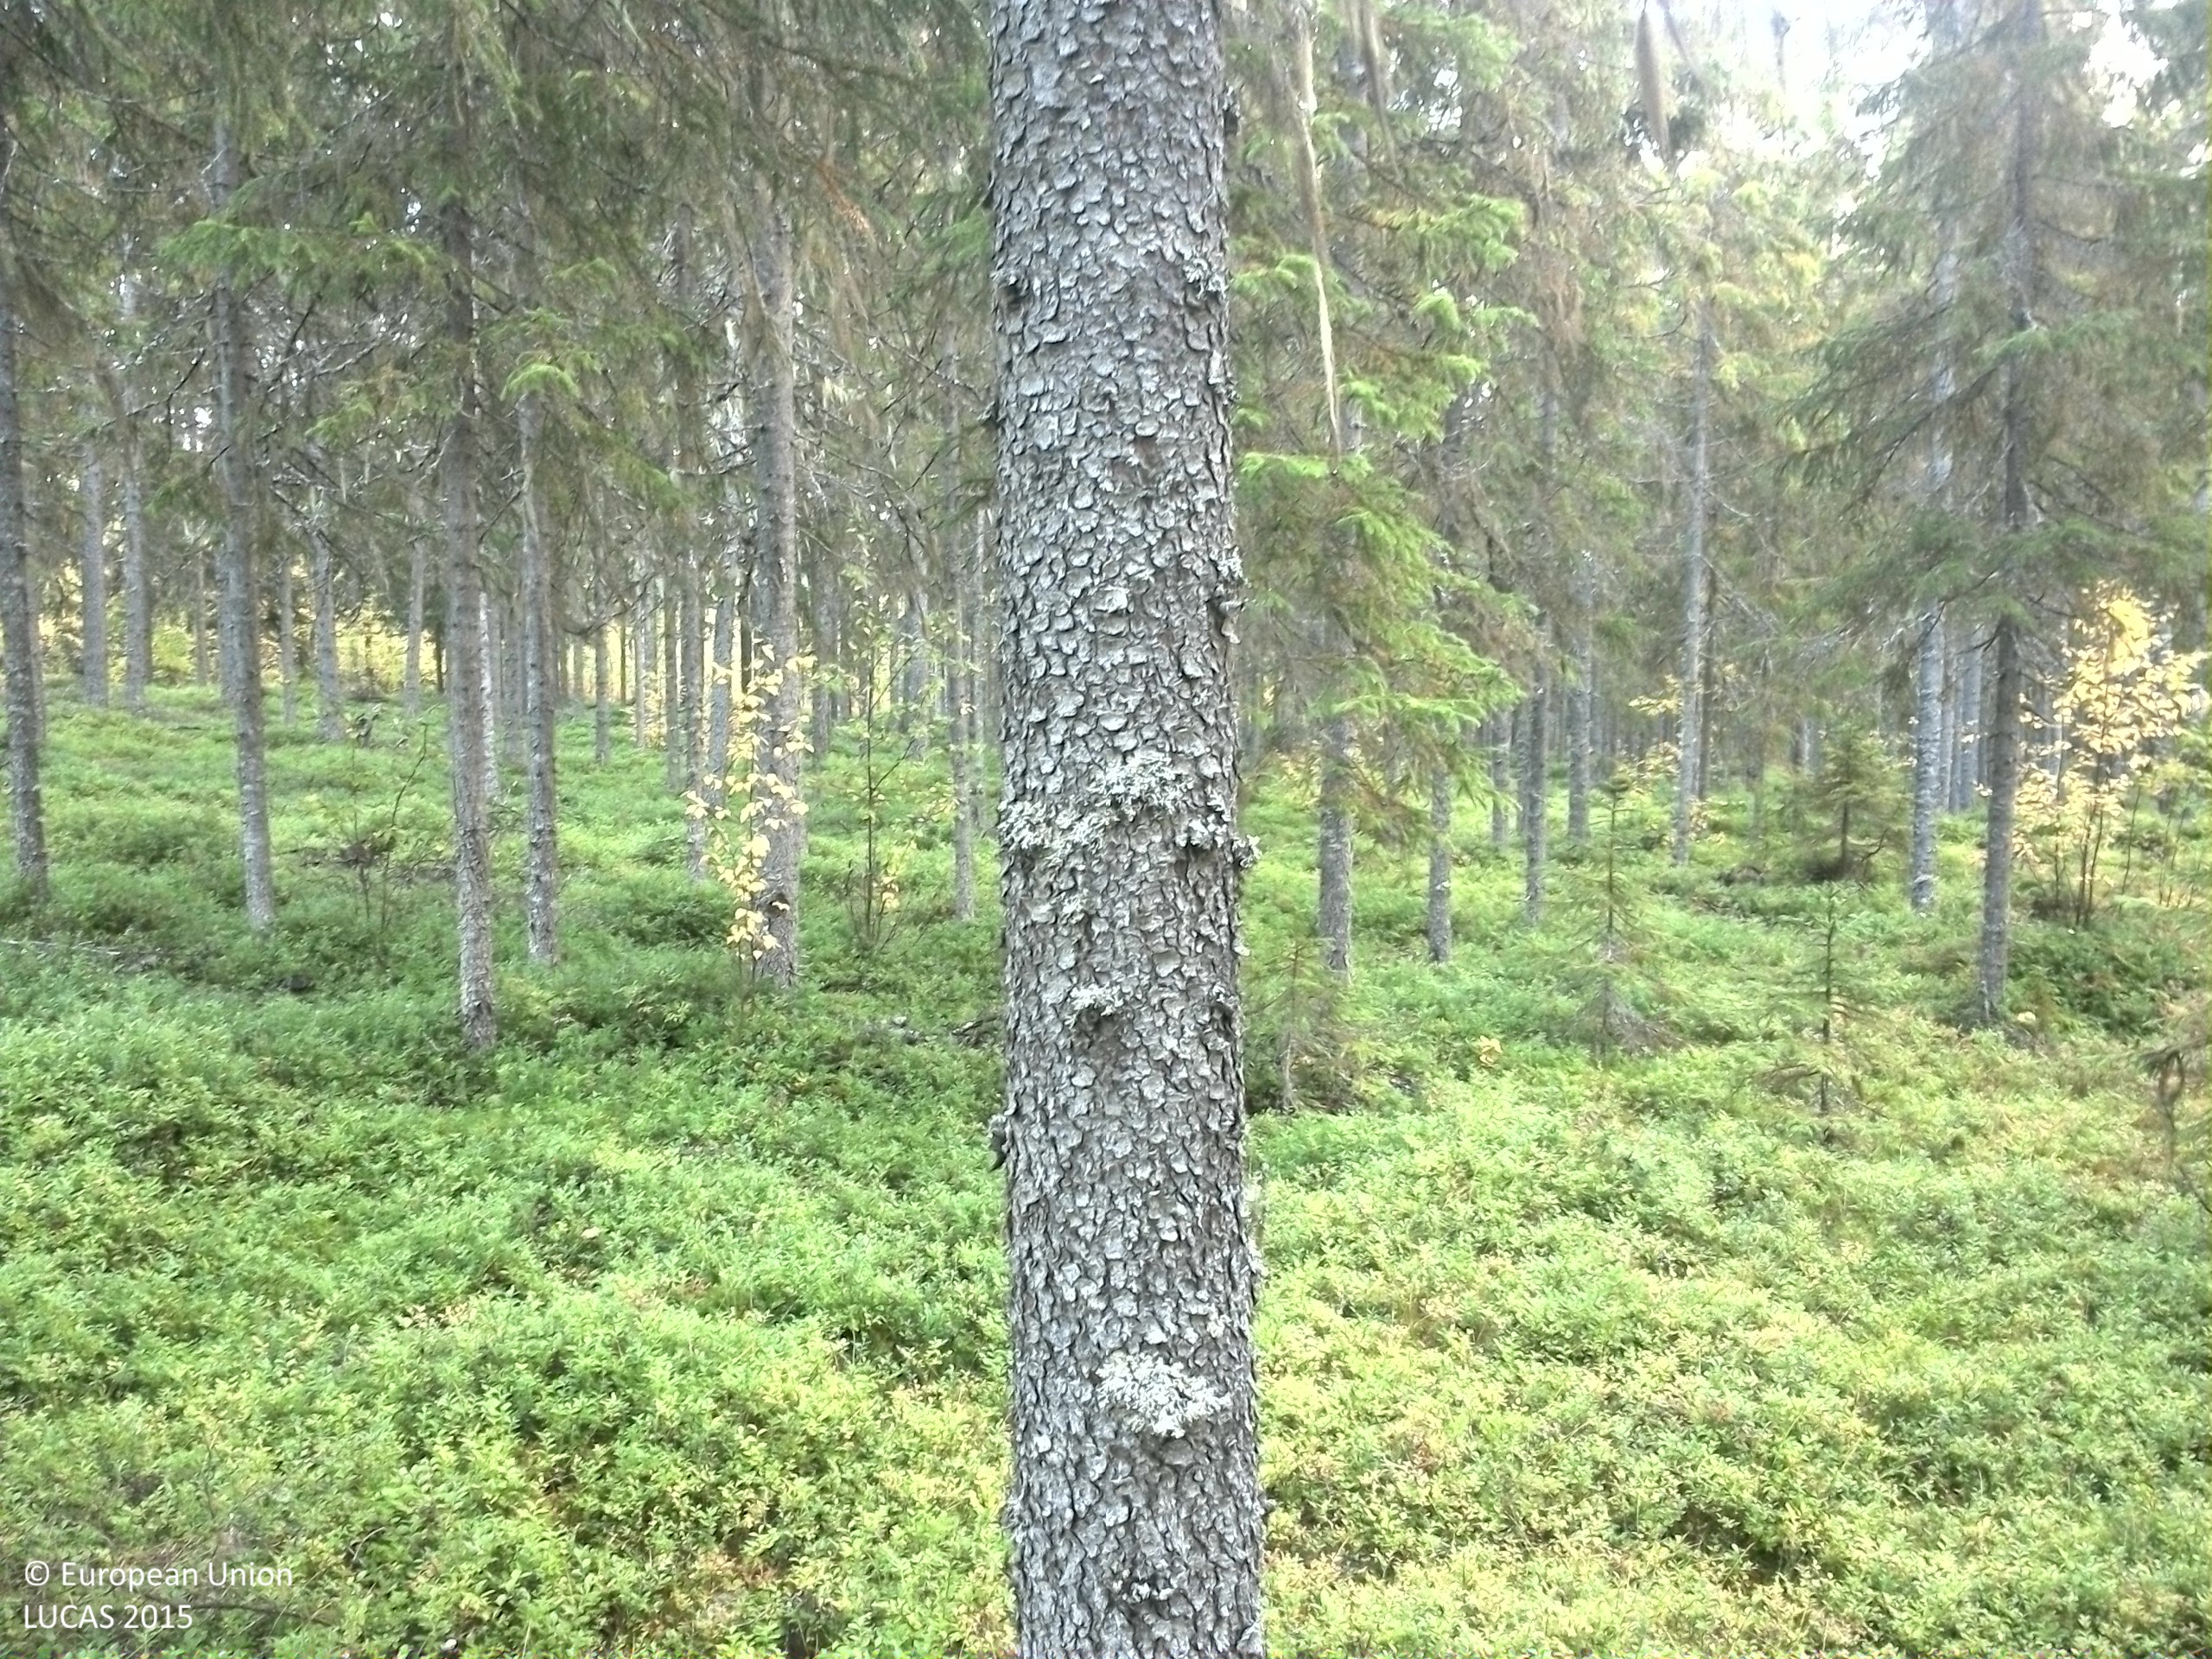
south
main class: Woodland
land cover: Spruce dominated coniferous woodland
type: boreal forest
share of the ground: 25 - 50 %
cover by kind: shrubs 50 %, coniferous forest trees 40 %, broadleaved forest trees 5 %, lichens and mosses 5 %
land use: Forestry
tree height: > 5 m
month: September
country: SE
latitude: 63.7683
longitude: 16.2385
